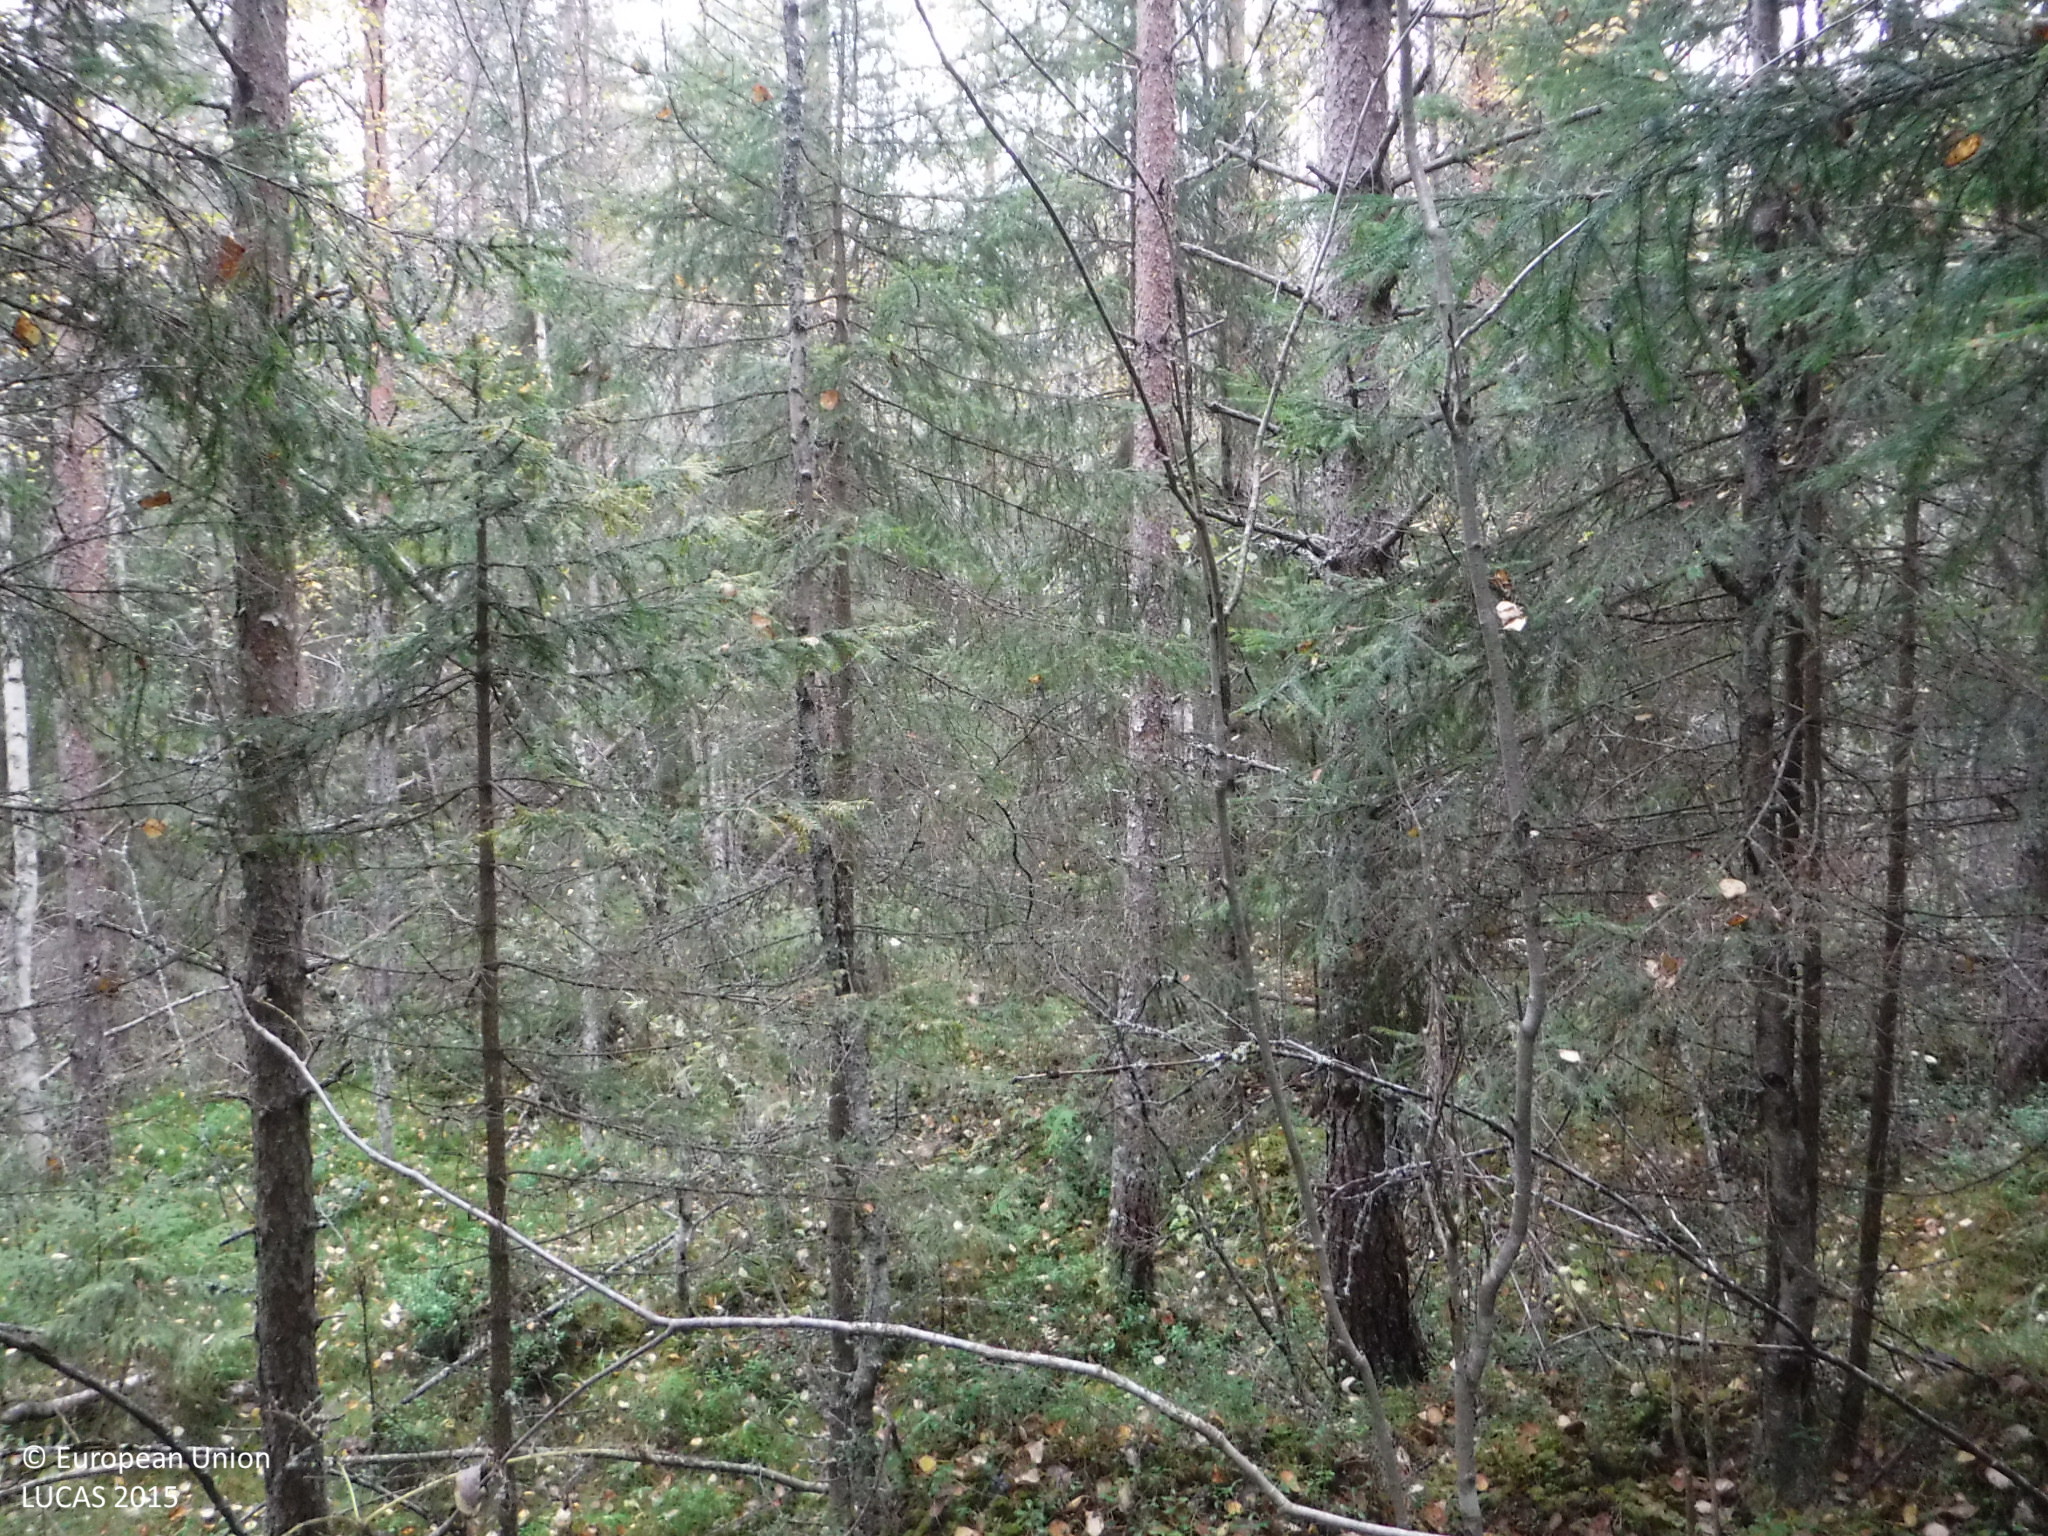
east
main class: Woodland
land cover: Other mixed woodland
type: boreal forest
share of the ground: > 75 %
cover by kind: coniferous forest trees 45 %, broadleaved forest trees 30 %, lichens and mosses 20 %, shrubs 5 %
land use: Forestry
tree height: > 5 m
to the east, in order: Other mixed woodland; Ditches and canals; Other mixed woodland; Pine dominated coniferous woodland; Inland fresh water bodies; Inland marshes; Pine dominated coniferous woodland
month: September
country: FI
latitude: 62.0919
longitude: 23.3049
